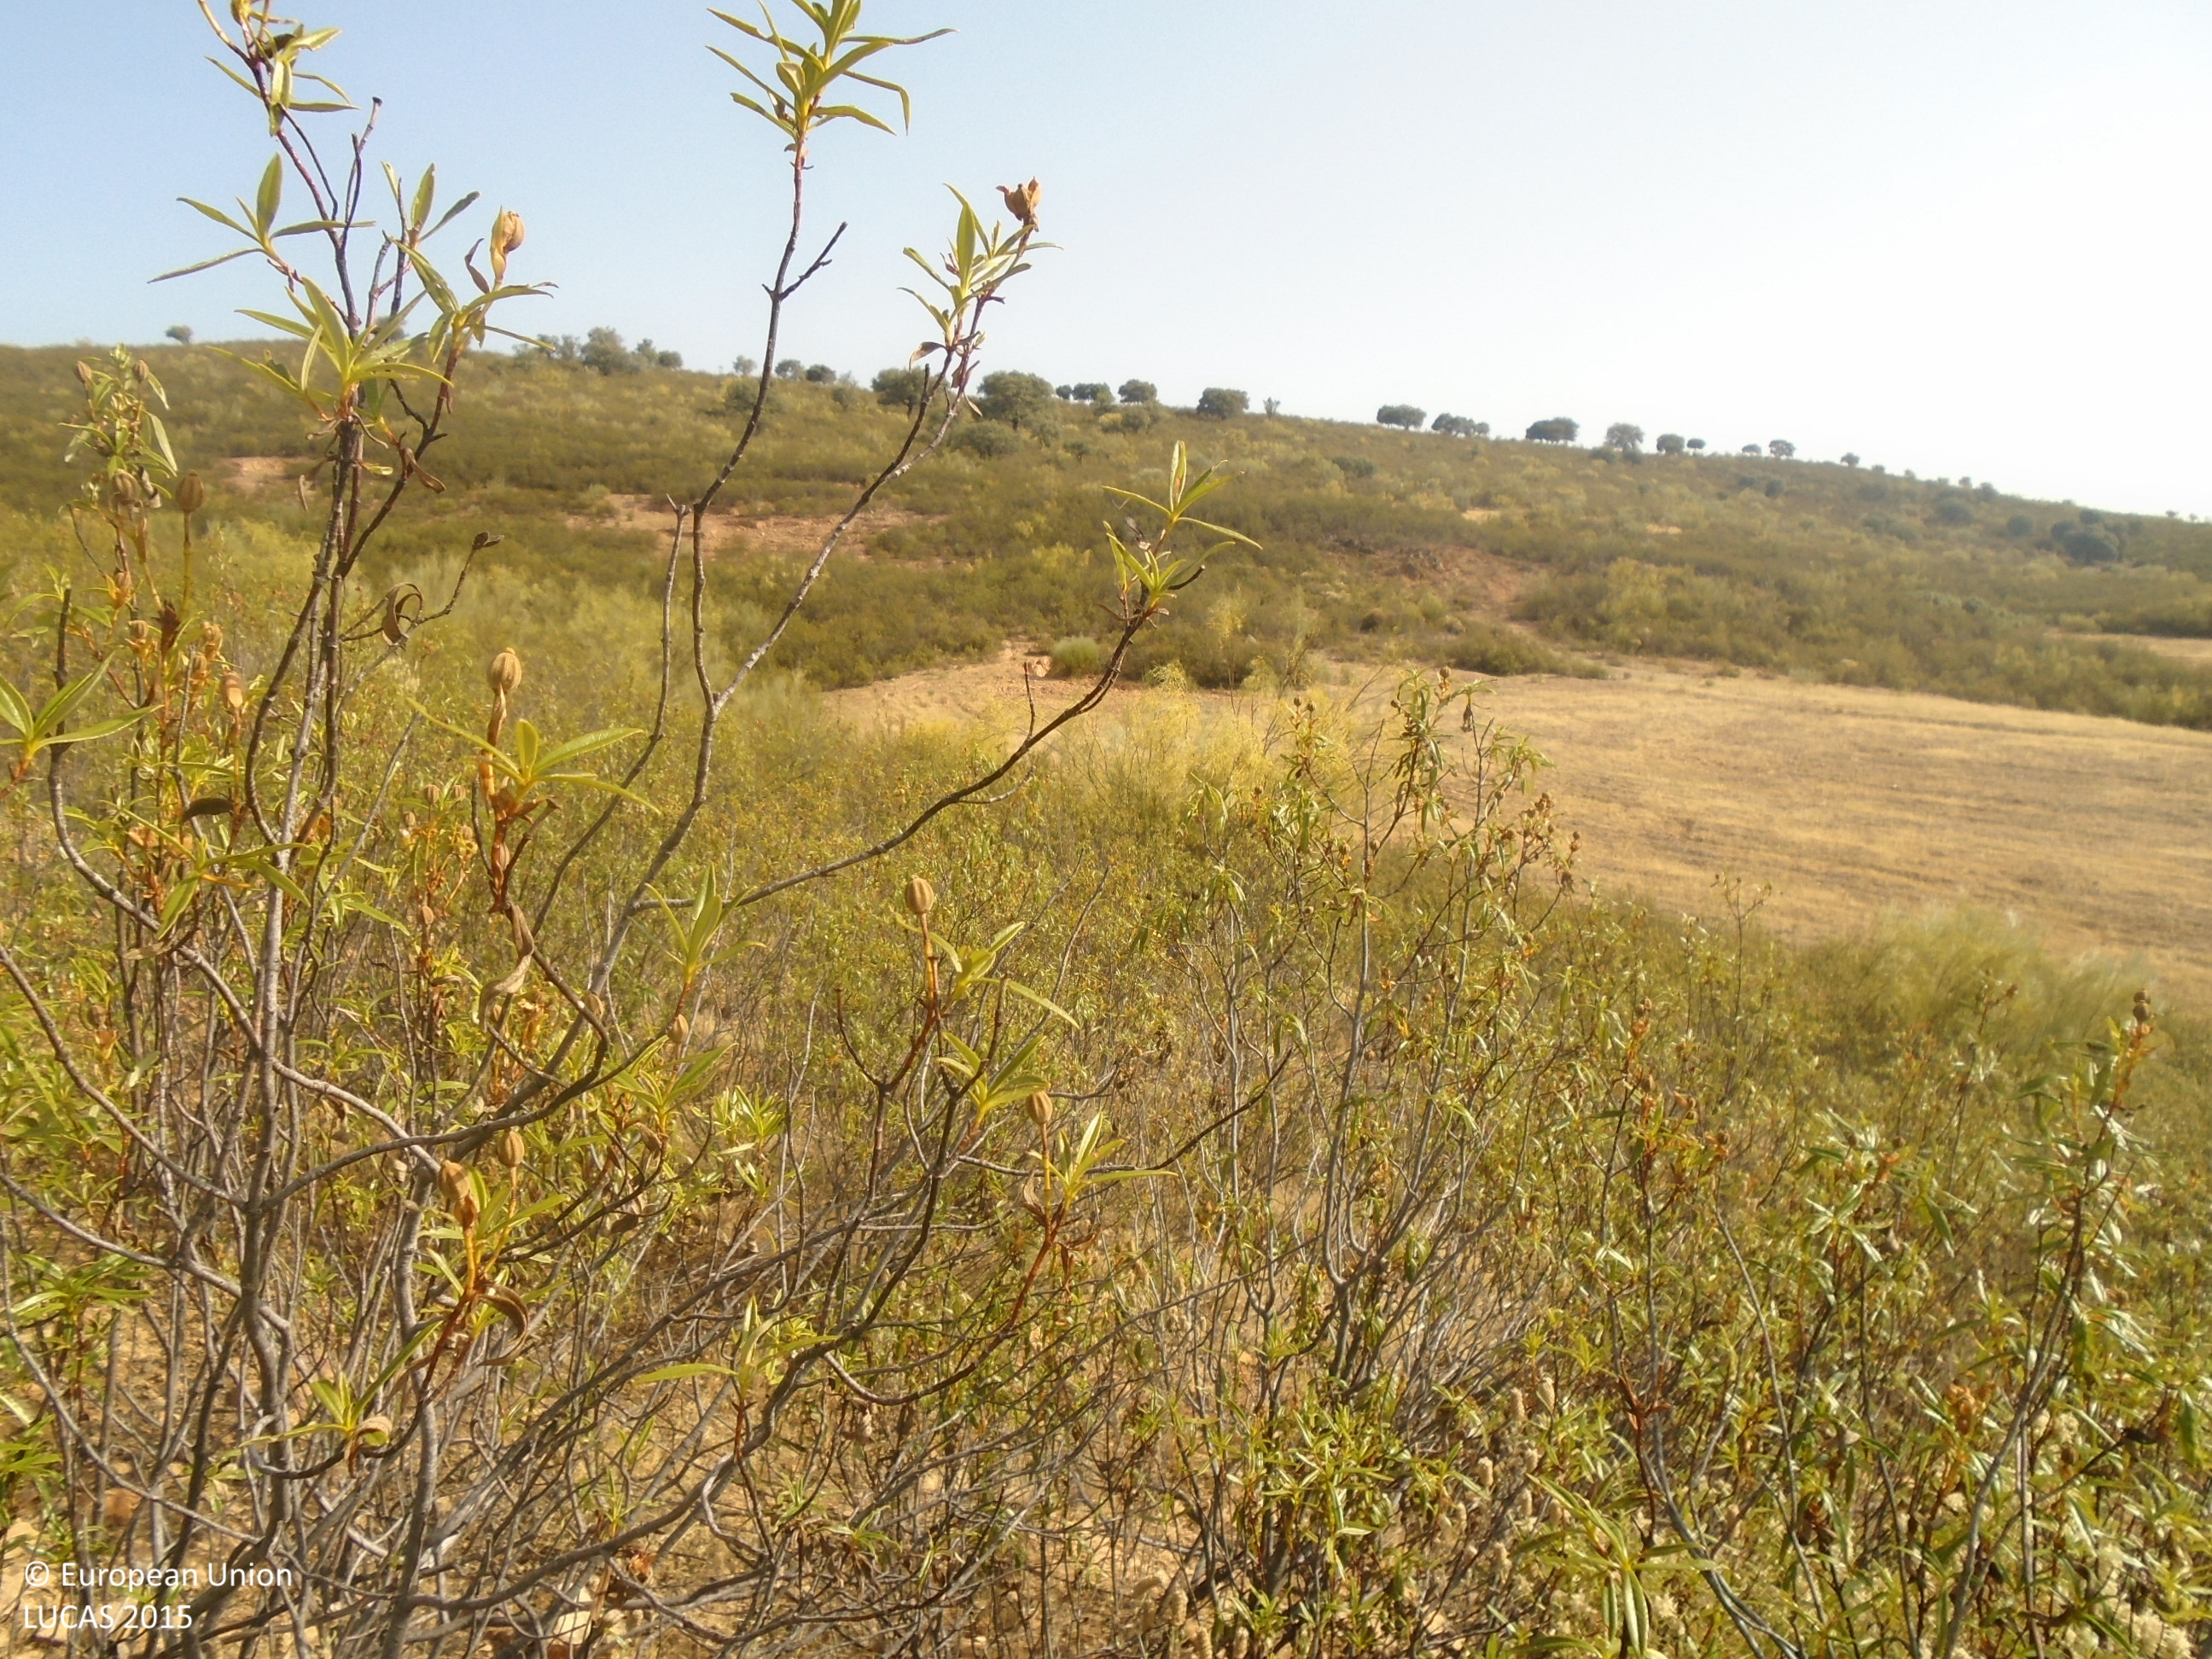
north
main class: Shrubland
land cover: Shrubland without tree cover
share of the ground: > 75 %
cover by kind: shrubs 90 %, herbaceous plants 10 %
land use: Semi-natural and natural areas not in use
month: July
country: ES
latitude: 39.2030
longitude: -4.4945
